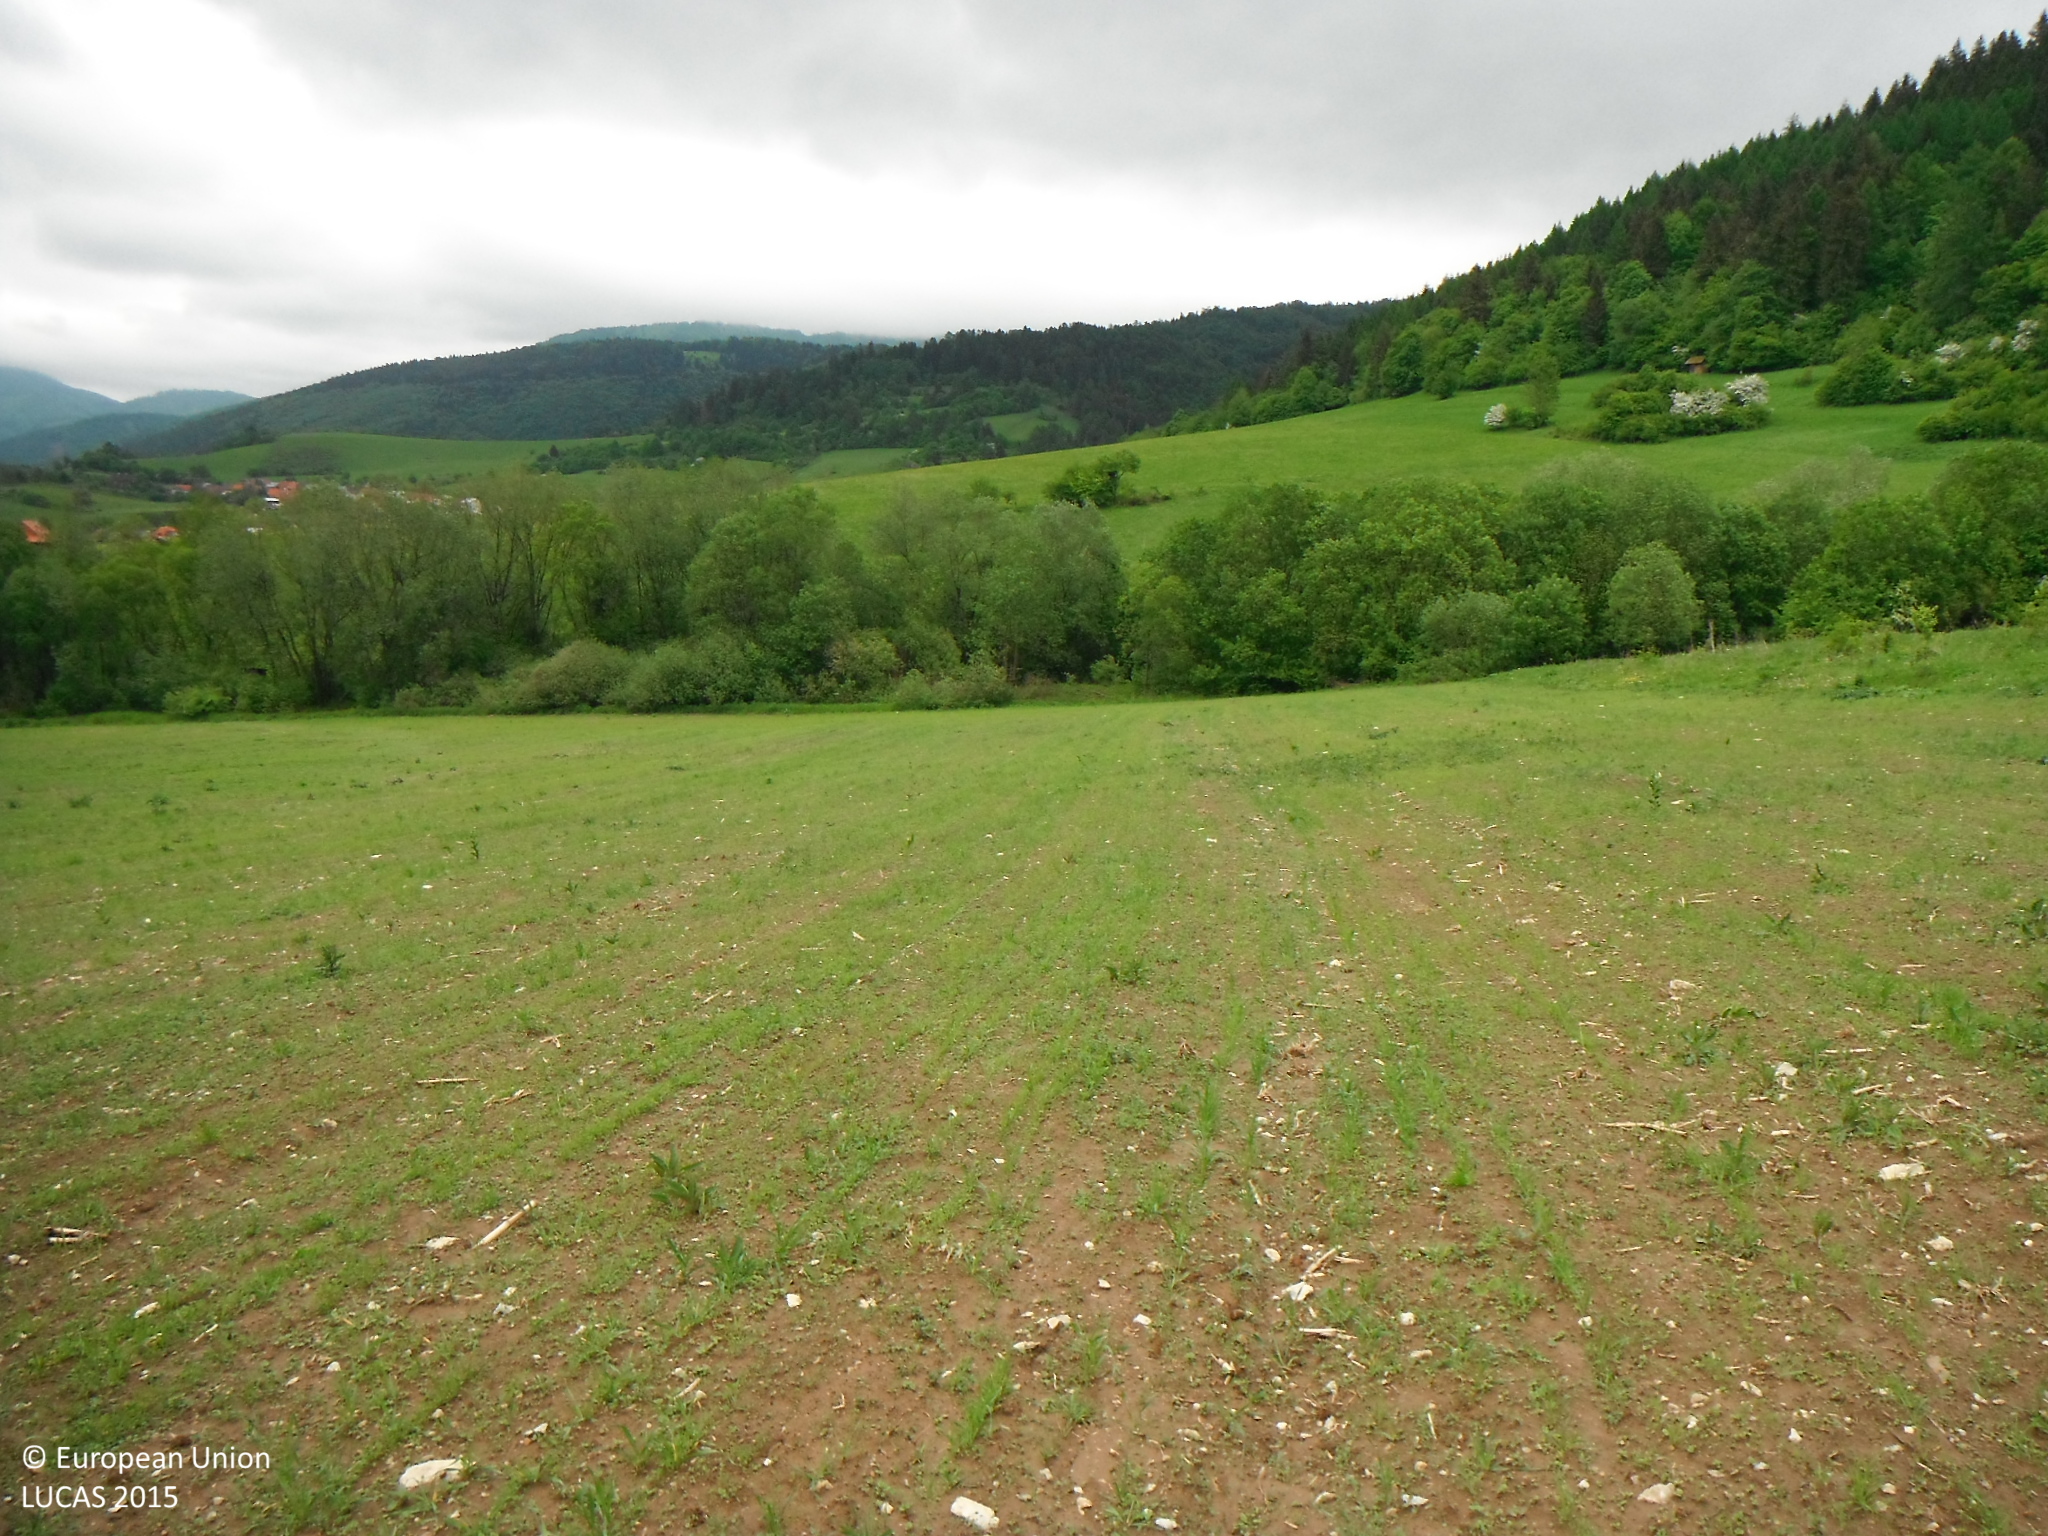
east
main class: Cropland
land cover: Common wheat
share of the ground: 25 - 50 %
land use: Agriculture (excluding fallow land and kitchen gardens)
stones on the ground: 10 - 25 %
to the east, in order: Common wheat; Spontaneously vegetated surfaces; Broadleaved woodland; Rivers and streams; Broadleaved woodland; Tracks; Grass margins; Broadleaved woodland; Grassland without tree/shrub cover; Tracks; Grassland without tree/shrub cover
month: May
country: SK
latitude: 49.0821
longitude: 19.0448
